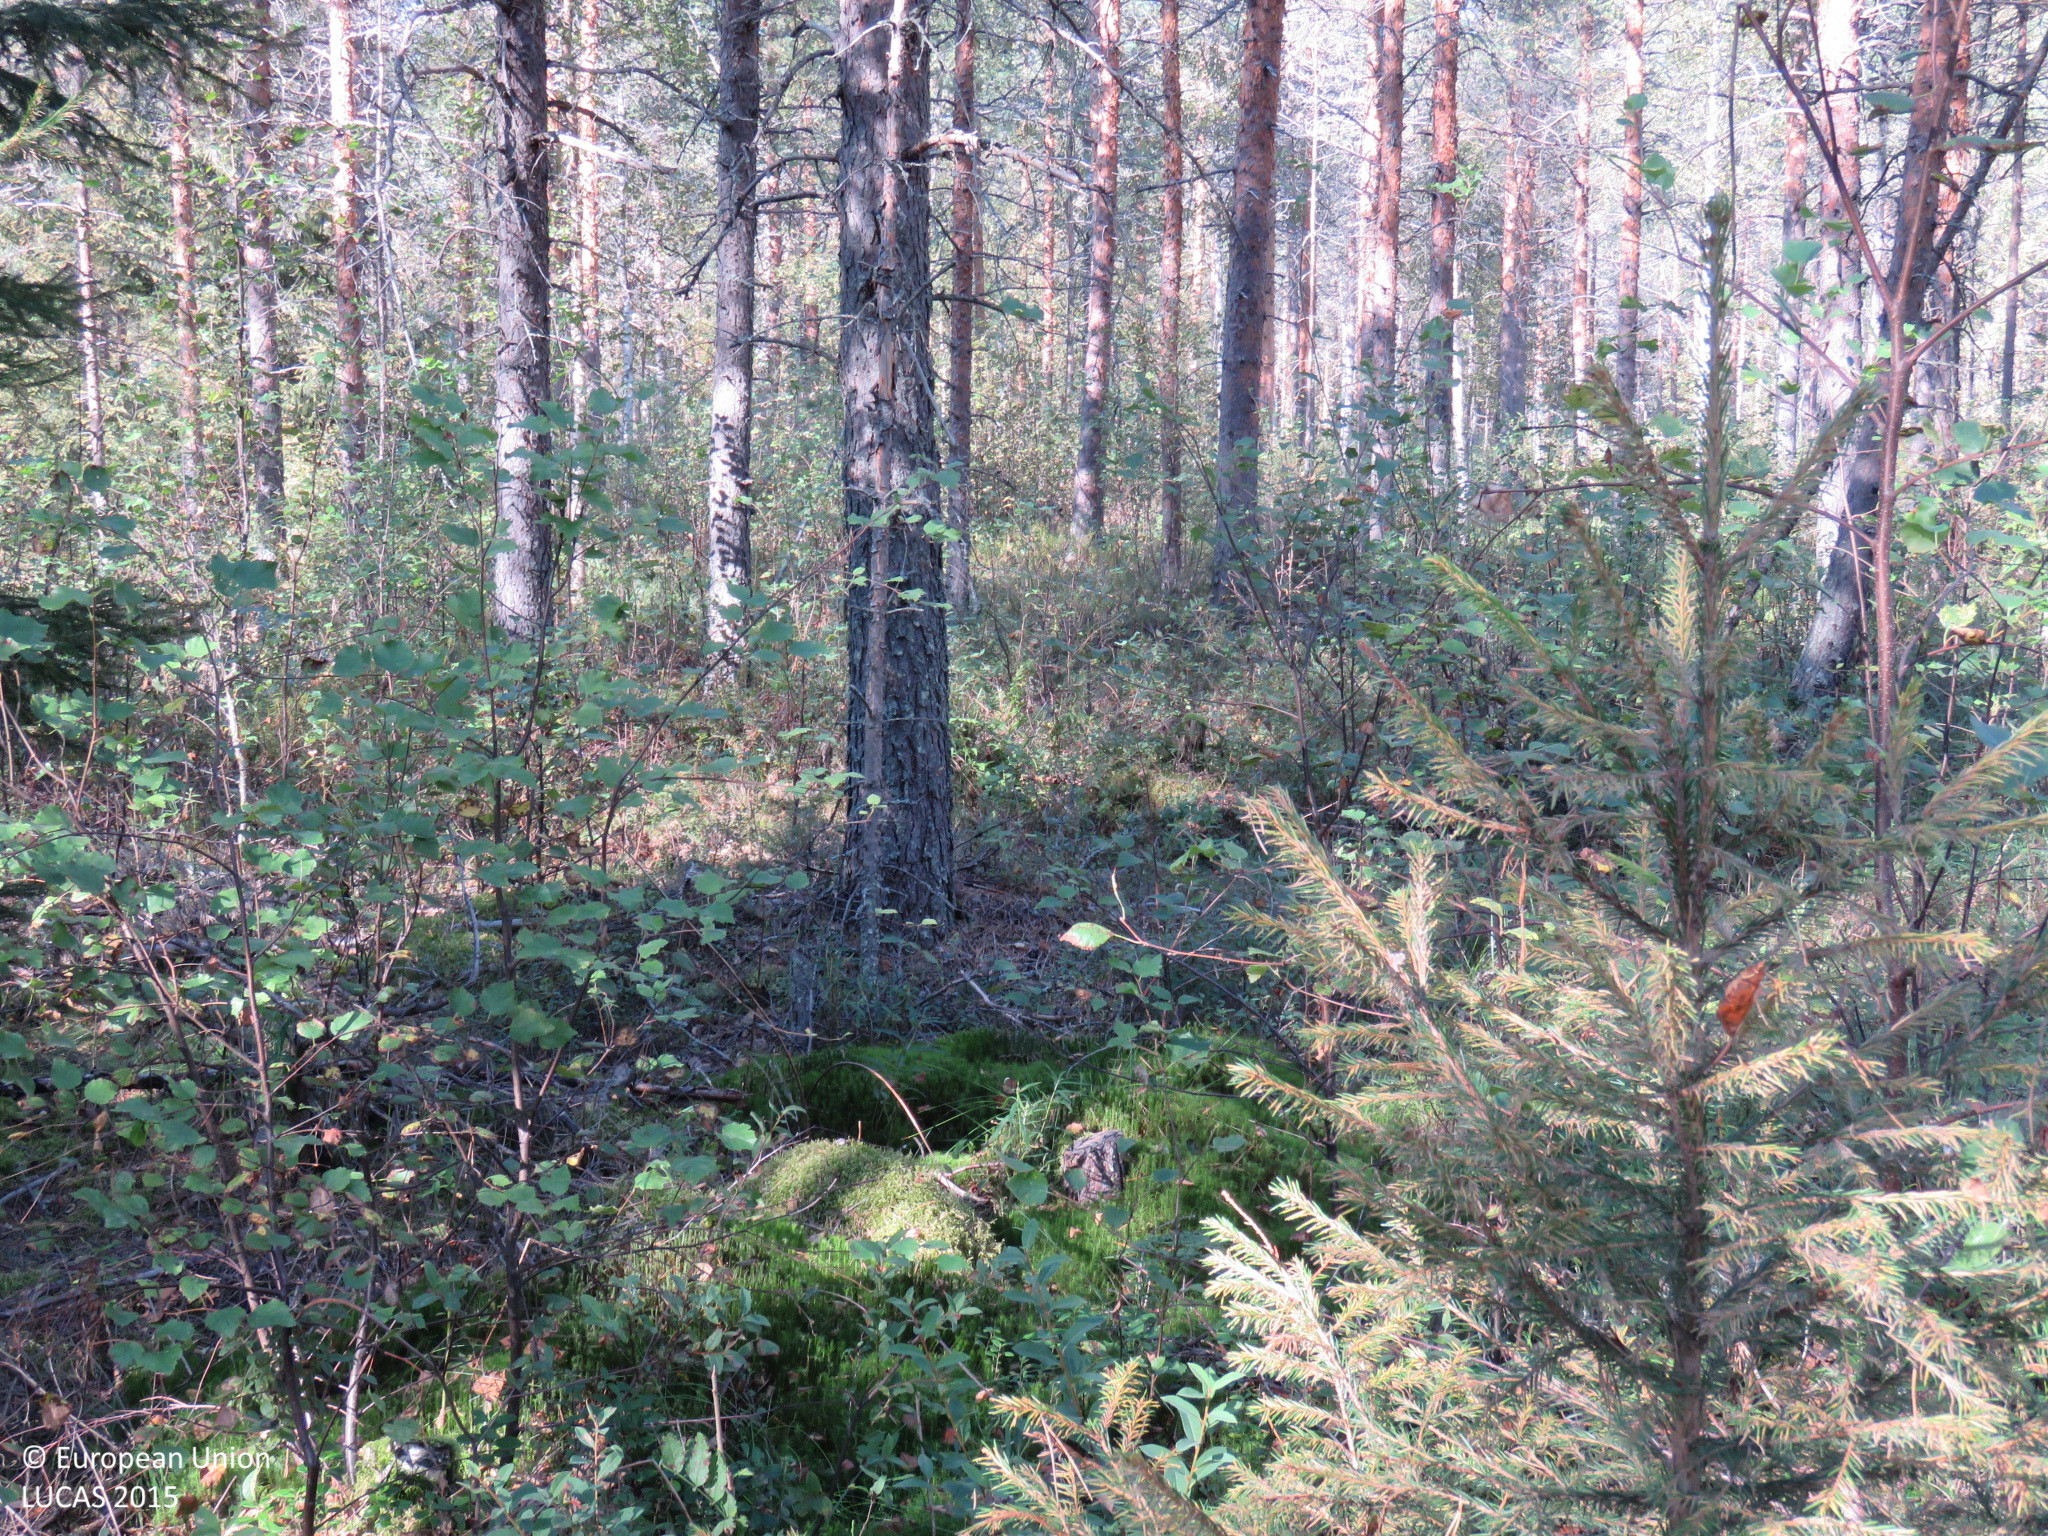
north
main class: Woodland
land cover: Pine dominated mixed woodland
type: mire and swamp forests
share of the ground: > 75 %
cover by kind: coniferous forest trees 60 %, broadleaved forest trees 25 %, shrubs 10 %, herbaceous plants 5 %
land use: Forestry
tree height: > 5 m
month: August
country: FI
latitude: 64.9998
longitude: 25.6745
